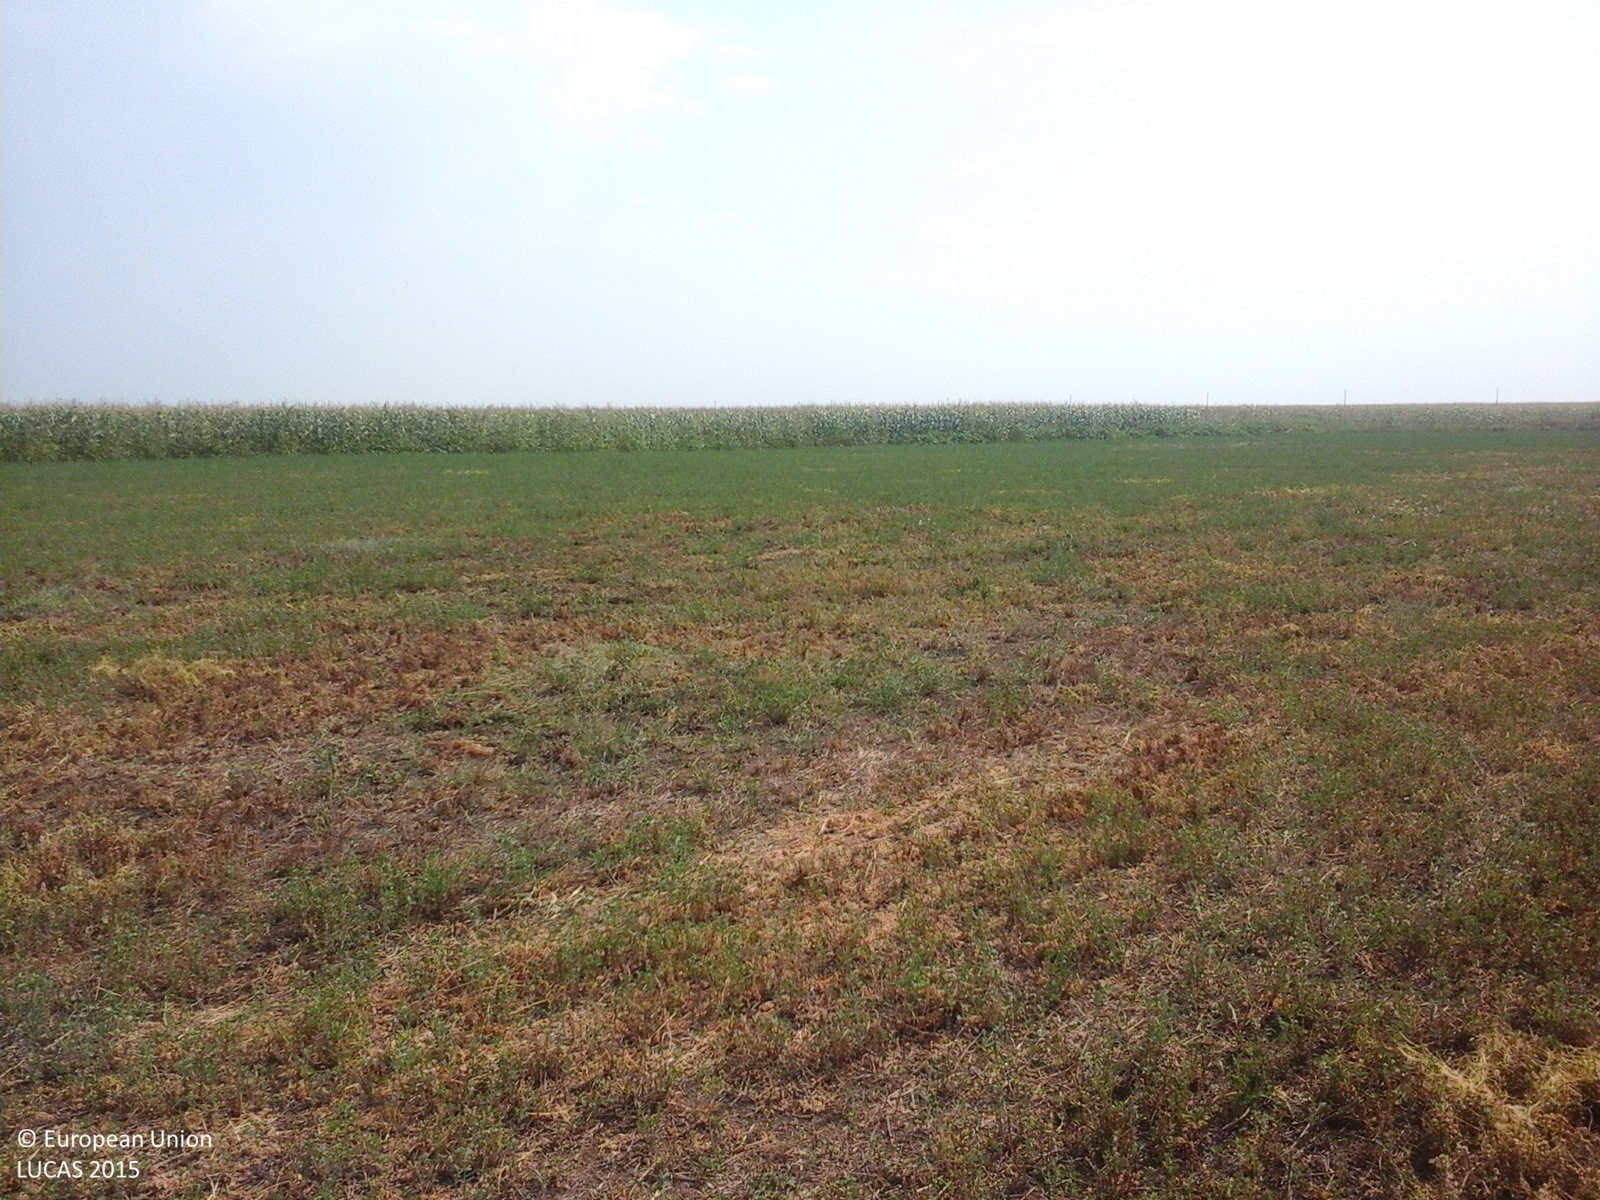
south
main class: Cropland
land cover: Lucerne
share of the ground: > 75 %
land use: Agriculture (excluding fallow land and kitchen gardens)
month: August
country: RO
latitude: 45.0226
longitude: 27.3924
